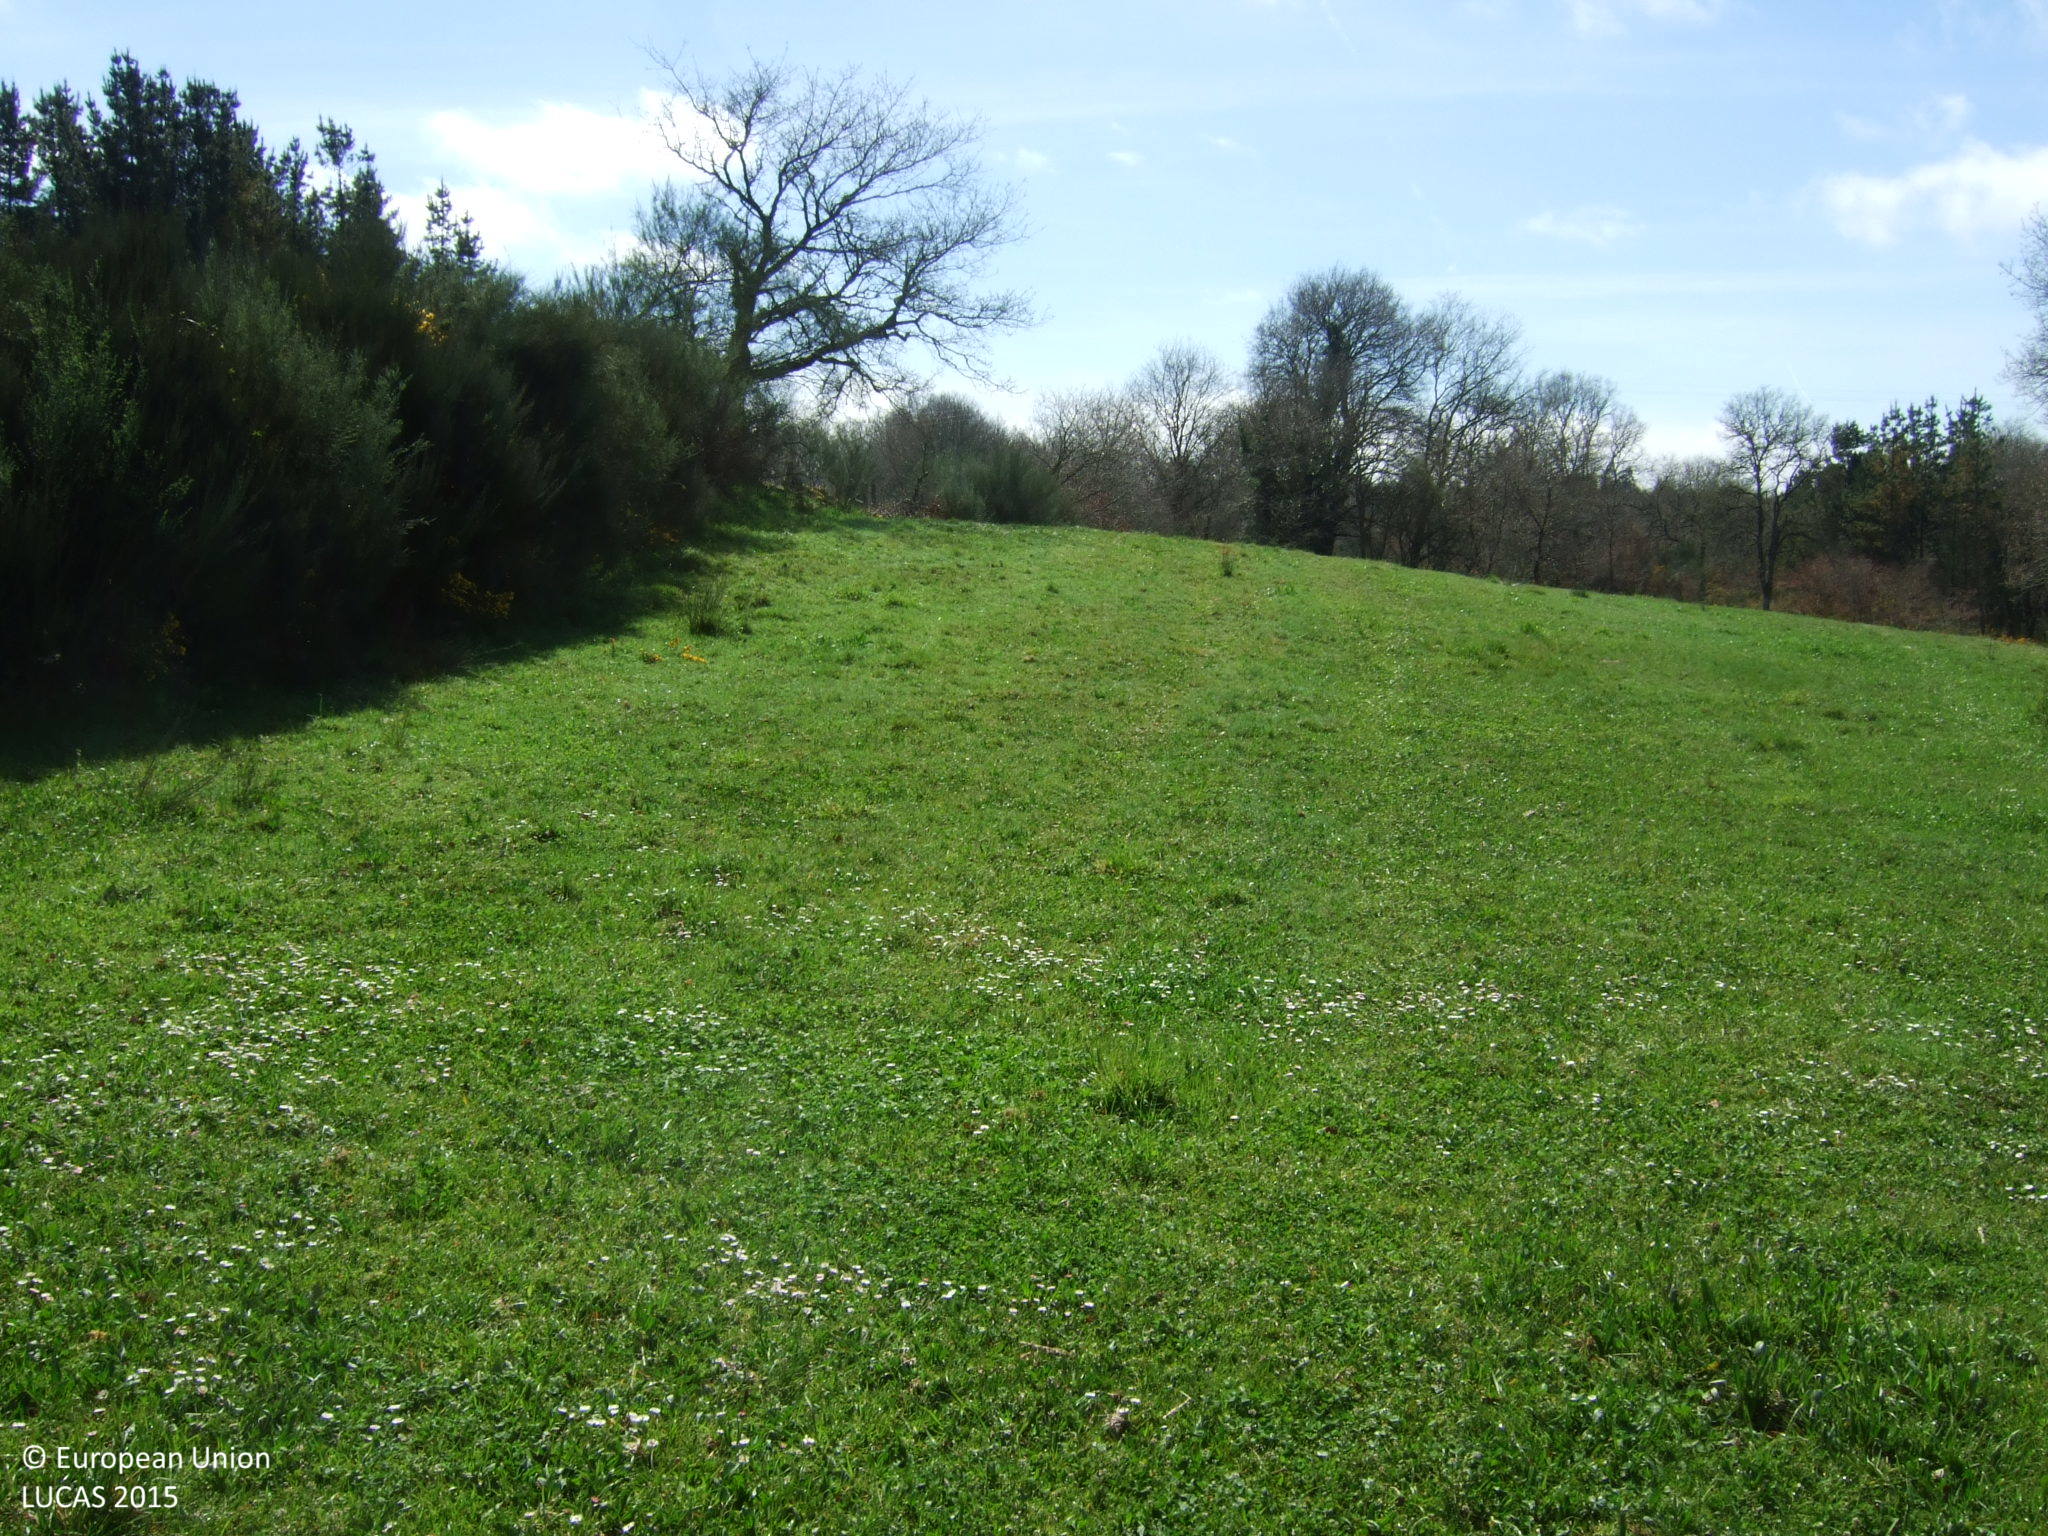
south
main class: Grassland
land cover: Grassland without tree/shrub cover
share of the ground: > 75 %
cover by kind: herbaceous plants 100 %
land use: Agriculture (excluding fallow land and kitchen gardens)
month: March
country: ES
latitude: 42.8317
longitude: -7.8082
